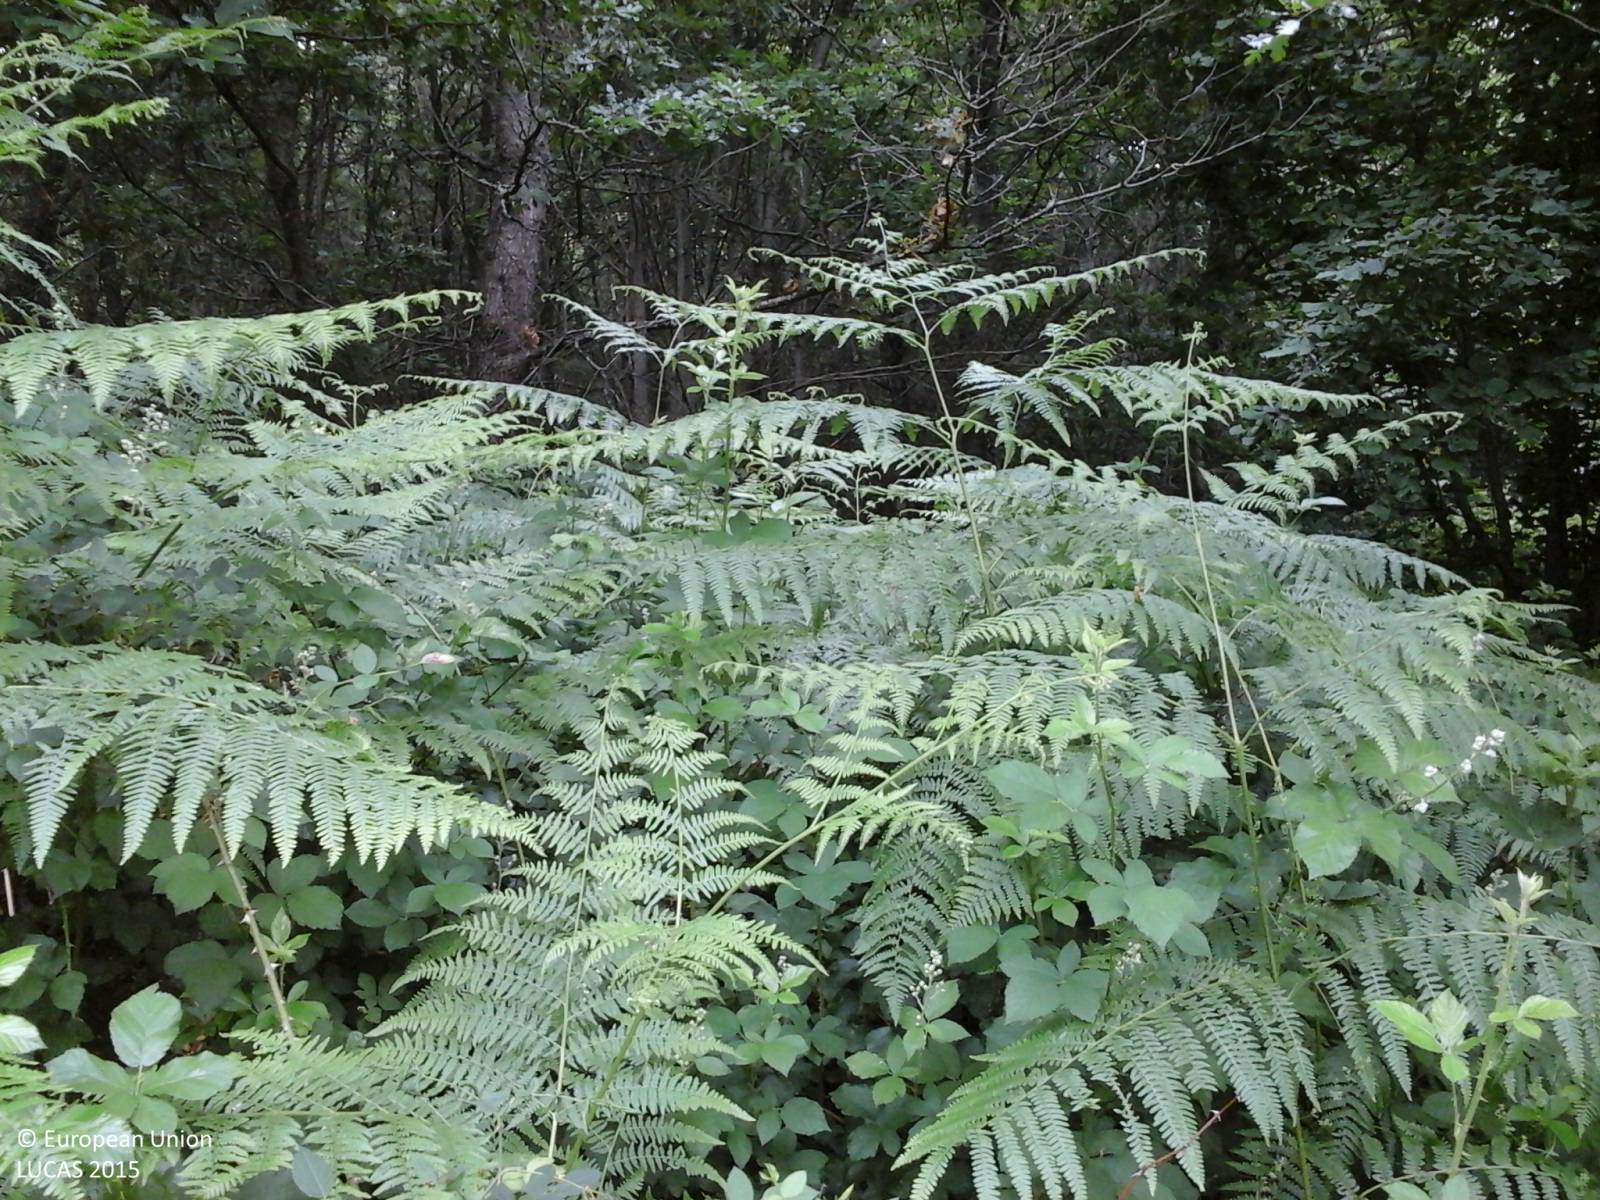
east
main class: Woodland
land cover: Broadleaved woodland
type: thermophilous deciduous forest
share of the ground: > 75 %
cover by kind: broadleaved forest trees 80 %, coniferous forest trees 20 %
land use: Forestry
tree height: > 5 m
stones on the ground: 25 - 50 %
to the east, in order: Broadleaved woodland; Tracks; Broadleaved woodland
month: June
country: IT
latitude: 42.3960
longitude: 12.1671
